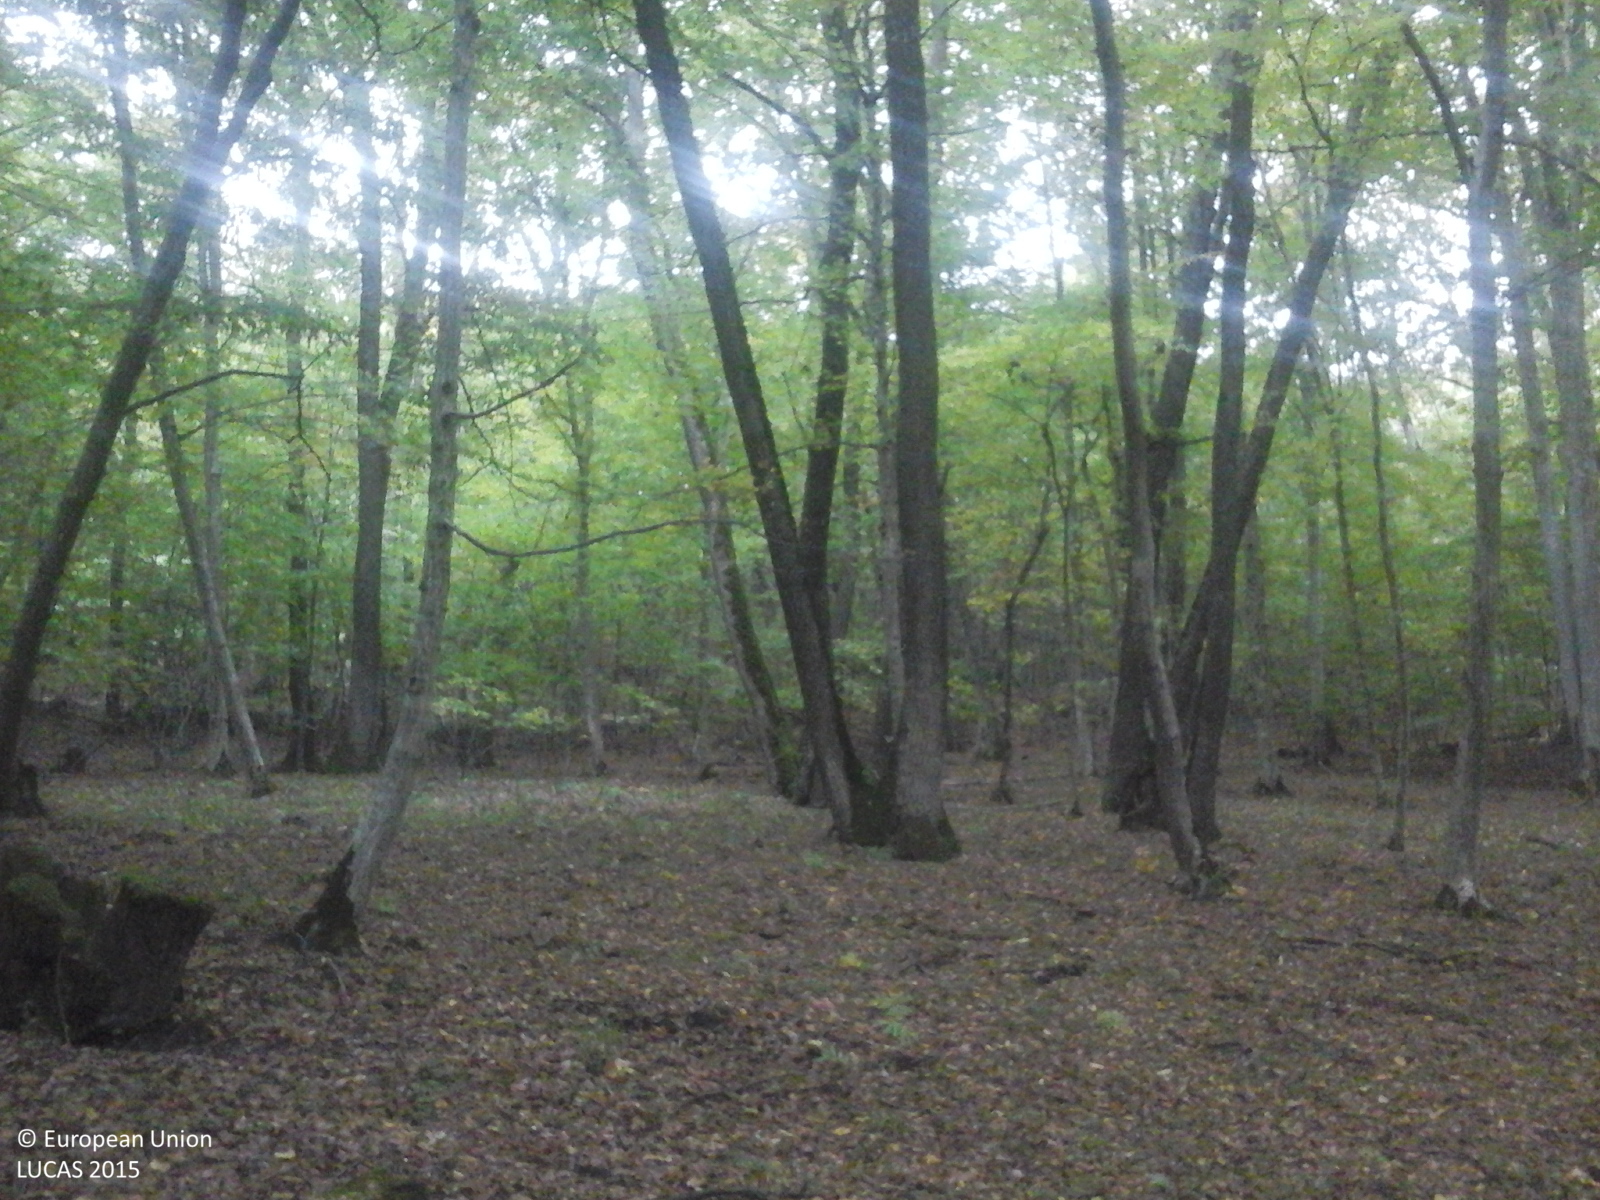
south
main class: Woodland
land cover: Broadleaved woodland
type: beech forest
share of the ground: > 75 %
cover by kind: broadleaved forest trees 100 %
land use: Forestry
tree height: > 5 m
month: October
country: RO
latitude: 45.9880
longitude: 25.0835
